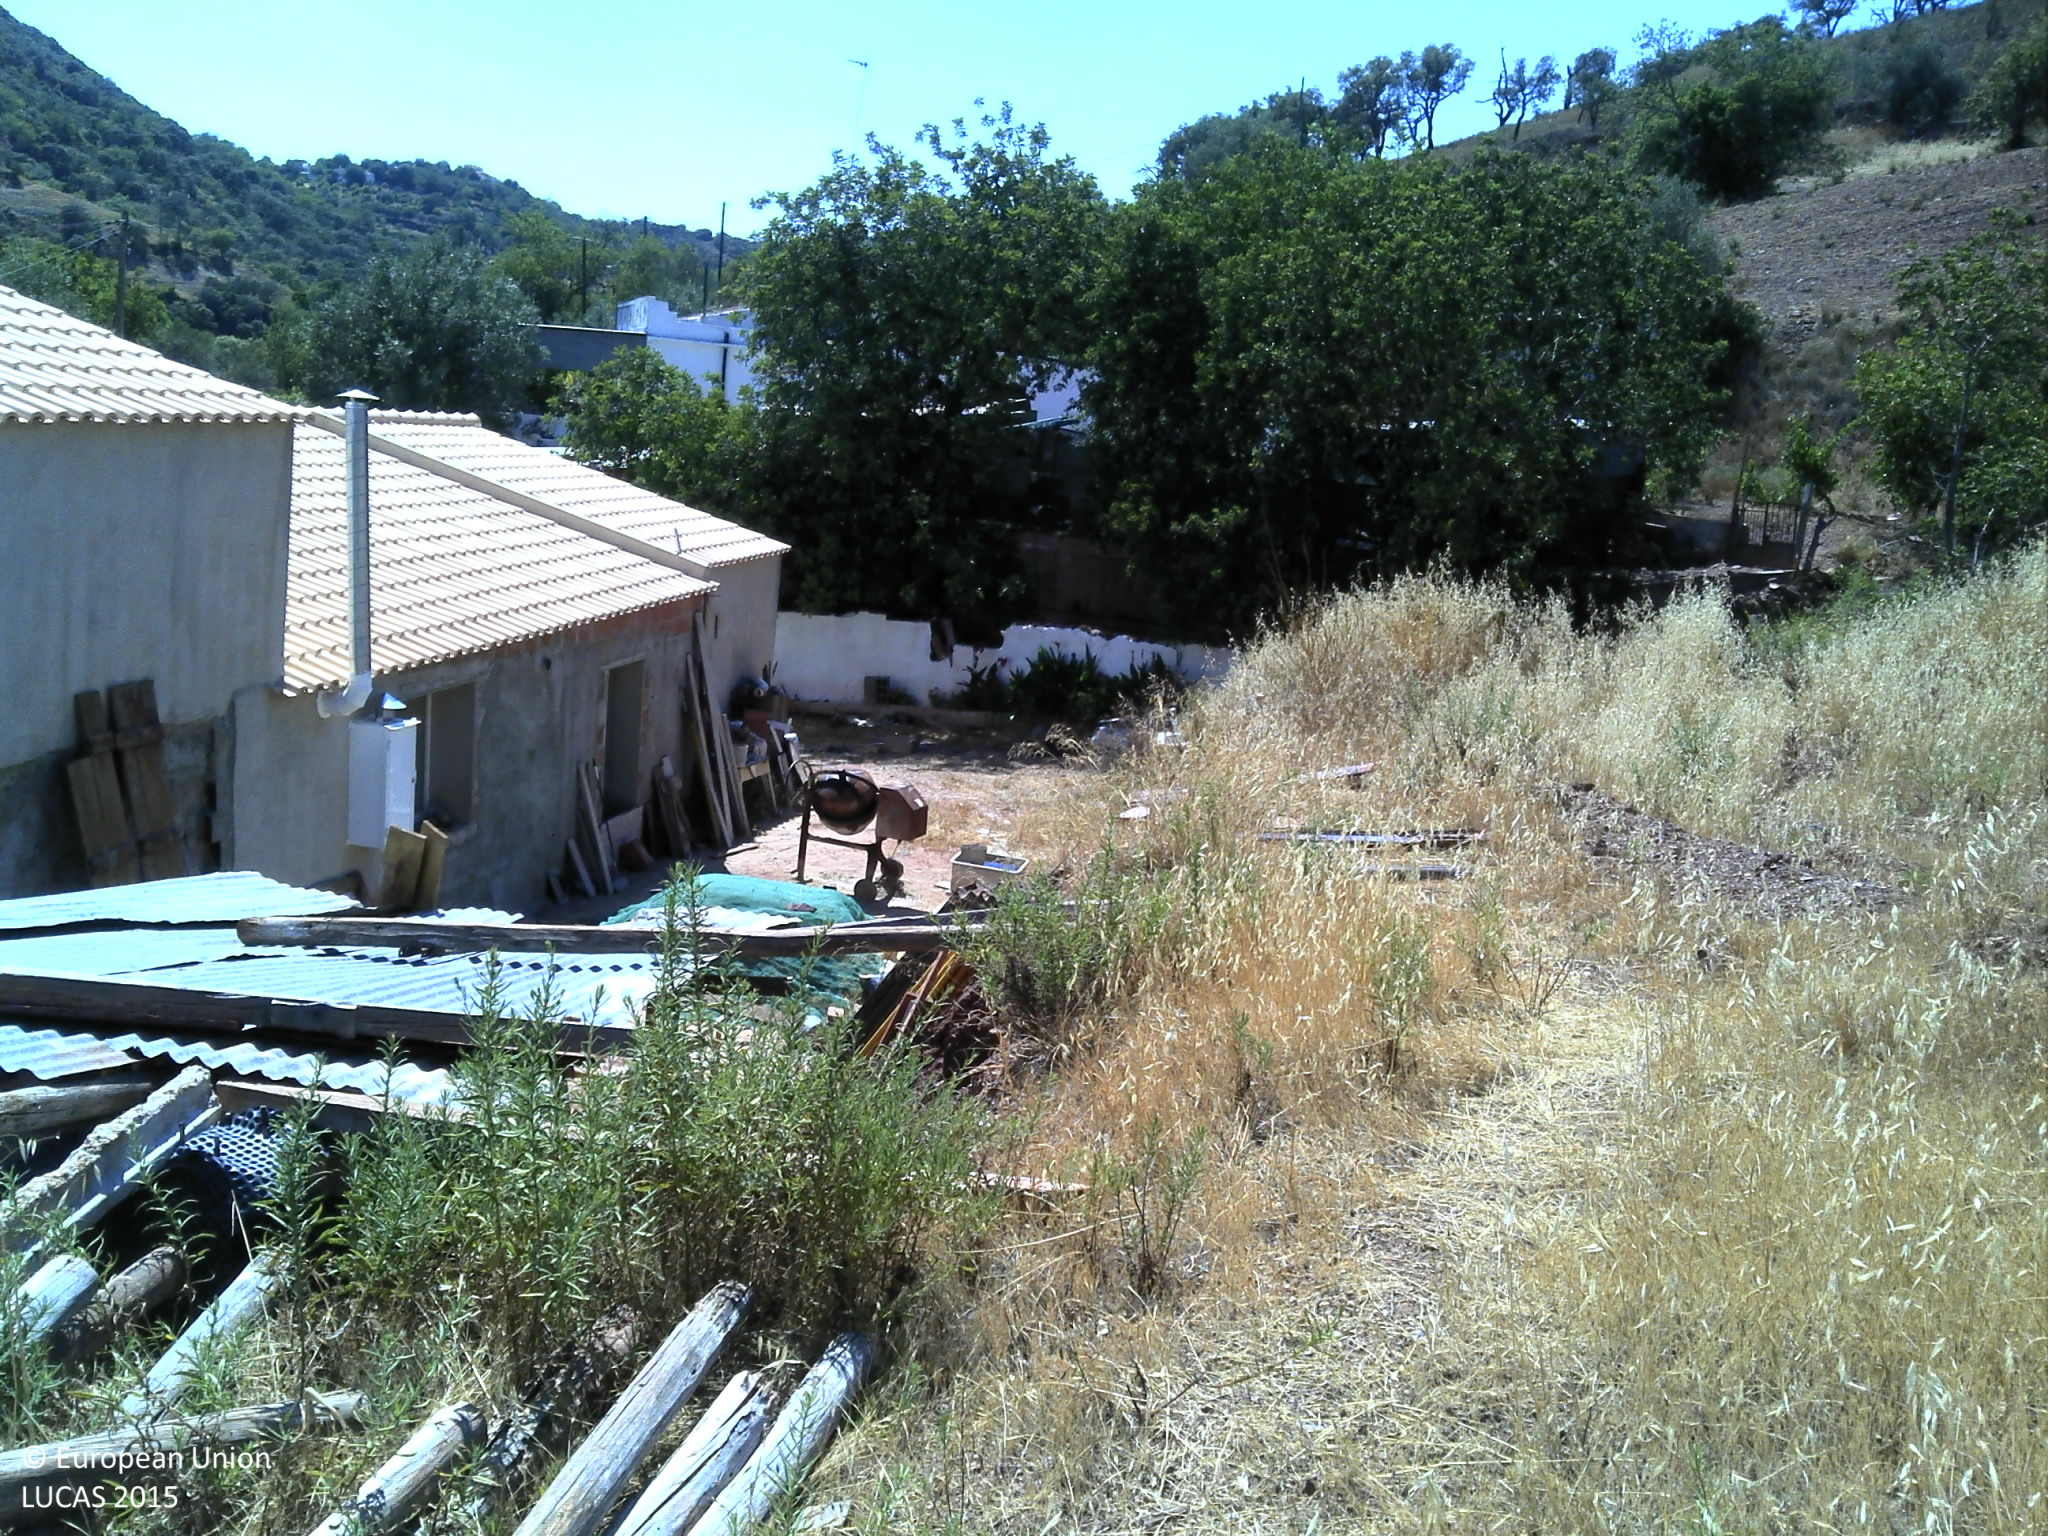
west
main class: Grassland
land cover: Grassland with sparse tree/shrub cover
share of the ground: > 75 %
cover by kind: herbaceous plants 85 %, unconsolidated bare surface 10 %, broadleaved forest trees 5 %
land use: Agriculture (excluding fallow land and kitchen gardens)
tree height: < 5 m
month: June
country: PT
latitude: 37.1575
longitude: -7.8345
